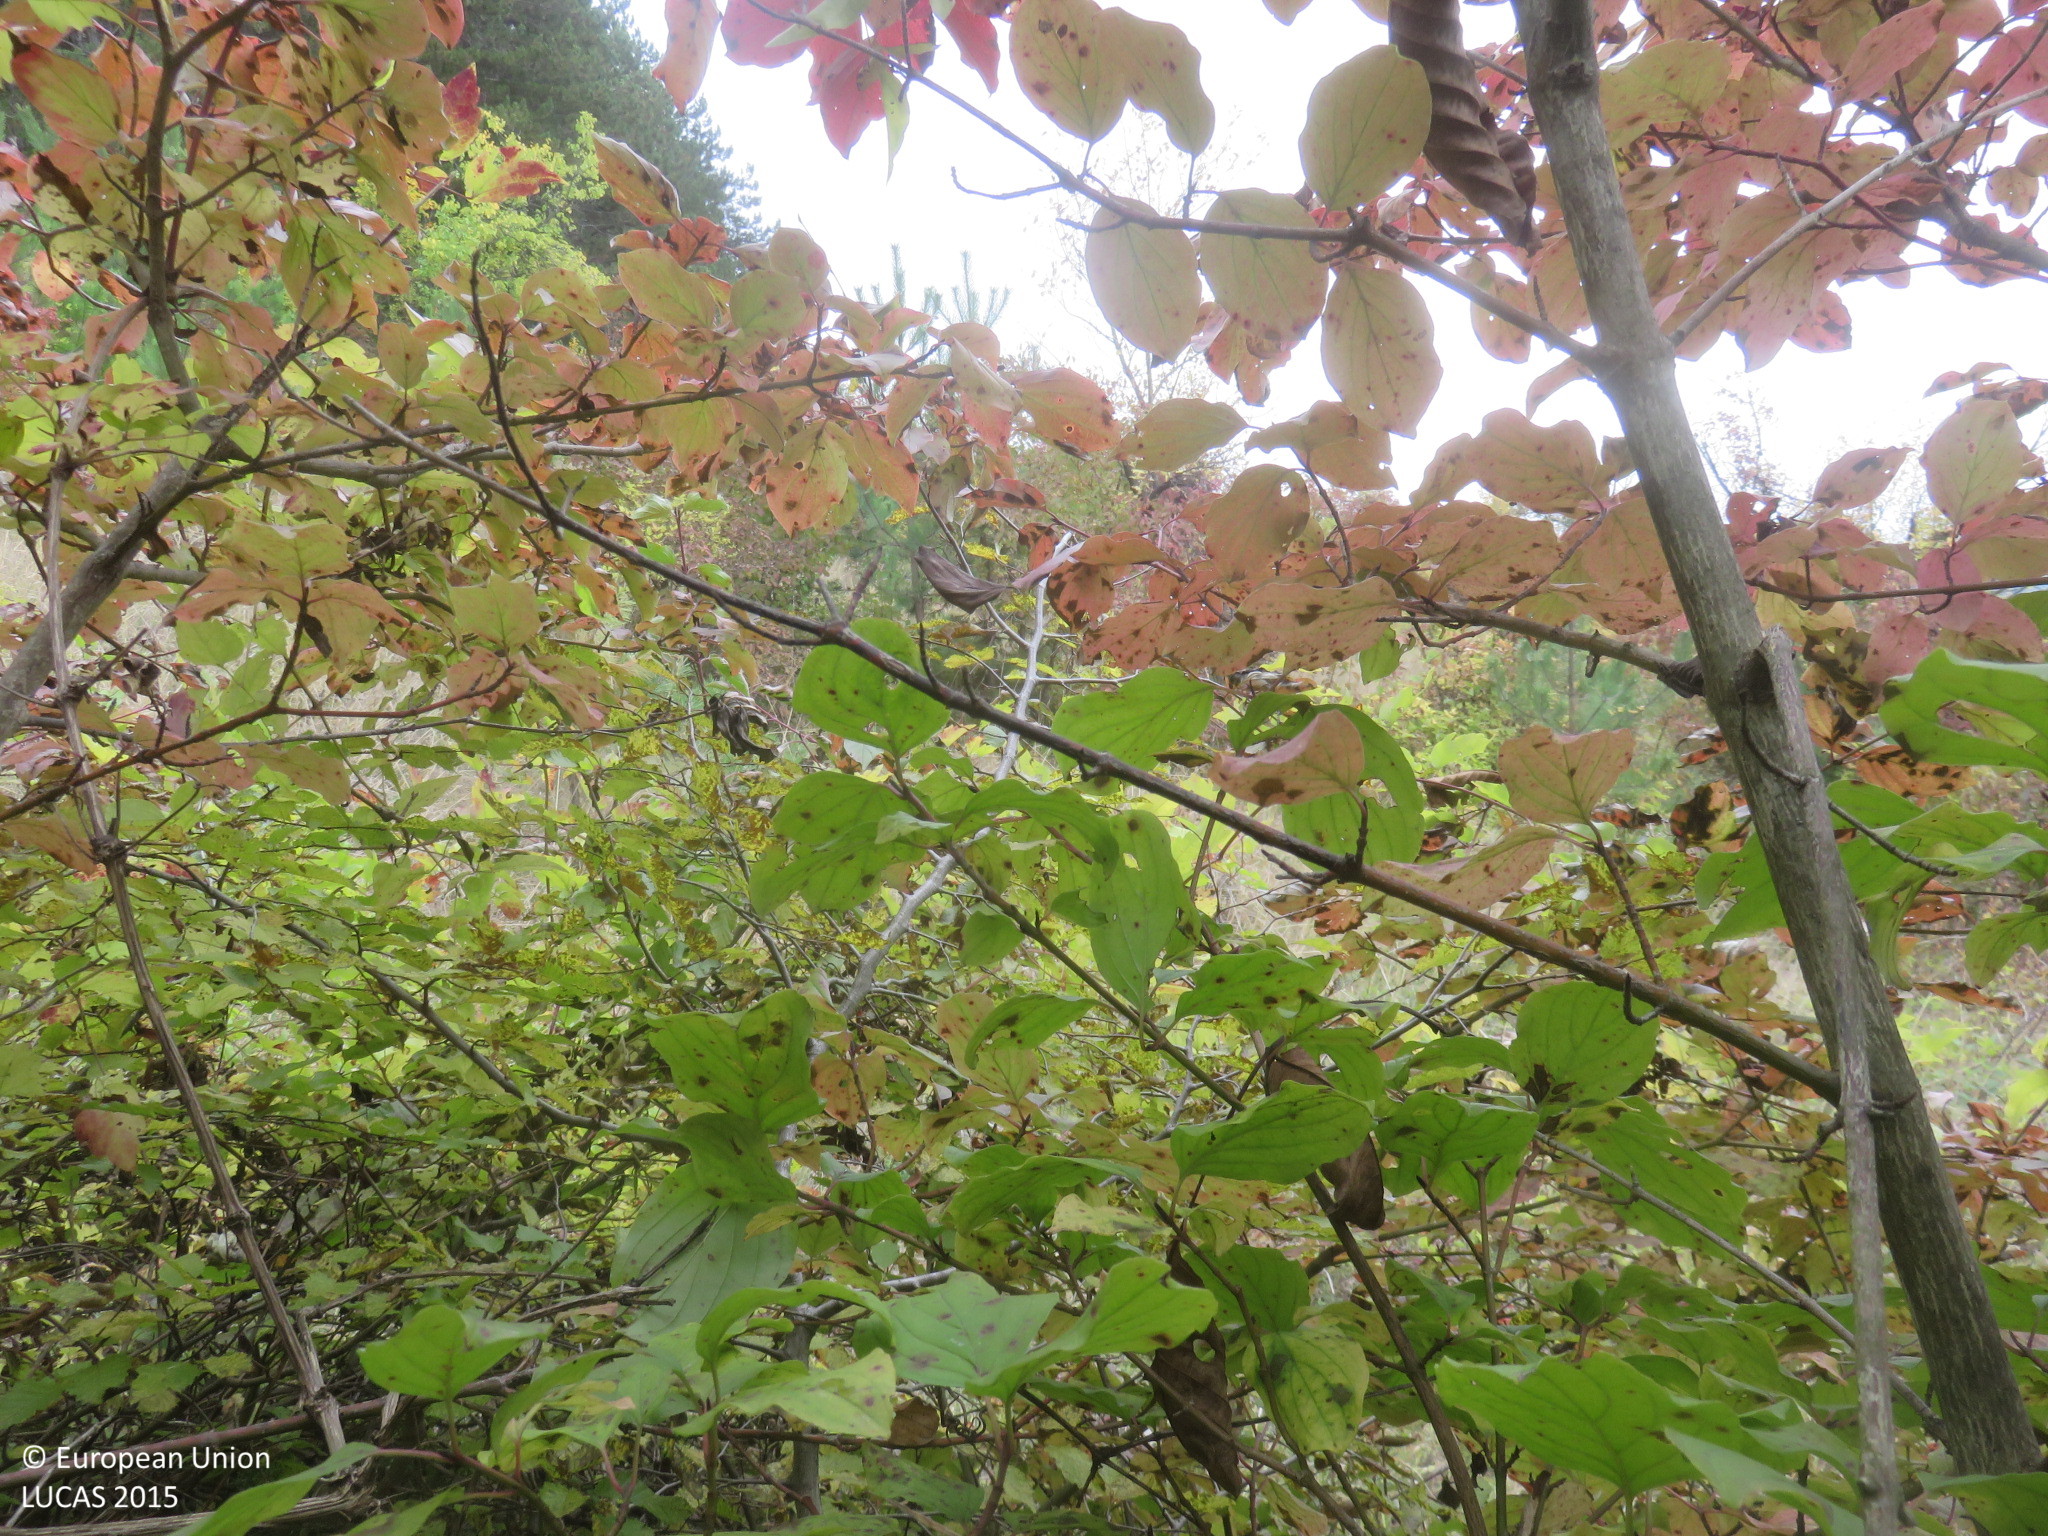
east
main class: Shrubland
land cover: Shrubland with sparse tree cover
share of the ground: > 75 %
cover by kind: shrubs 95 %, broadleaved forest trees 5 %
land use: Semi-natural and natural areas not in use
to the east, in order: Shrubland with sparse tree cover; Grassland with sparse tree/shrub cover; Grassland without tree/shrub cover; Broadleaved woodland; Shrubland with sparse tree cover; Grassland with sparse tree/shrub cover; Broadleaved woodland
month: October
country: BG
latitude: 43.0044
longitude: 24.9455
